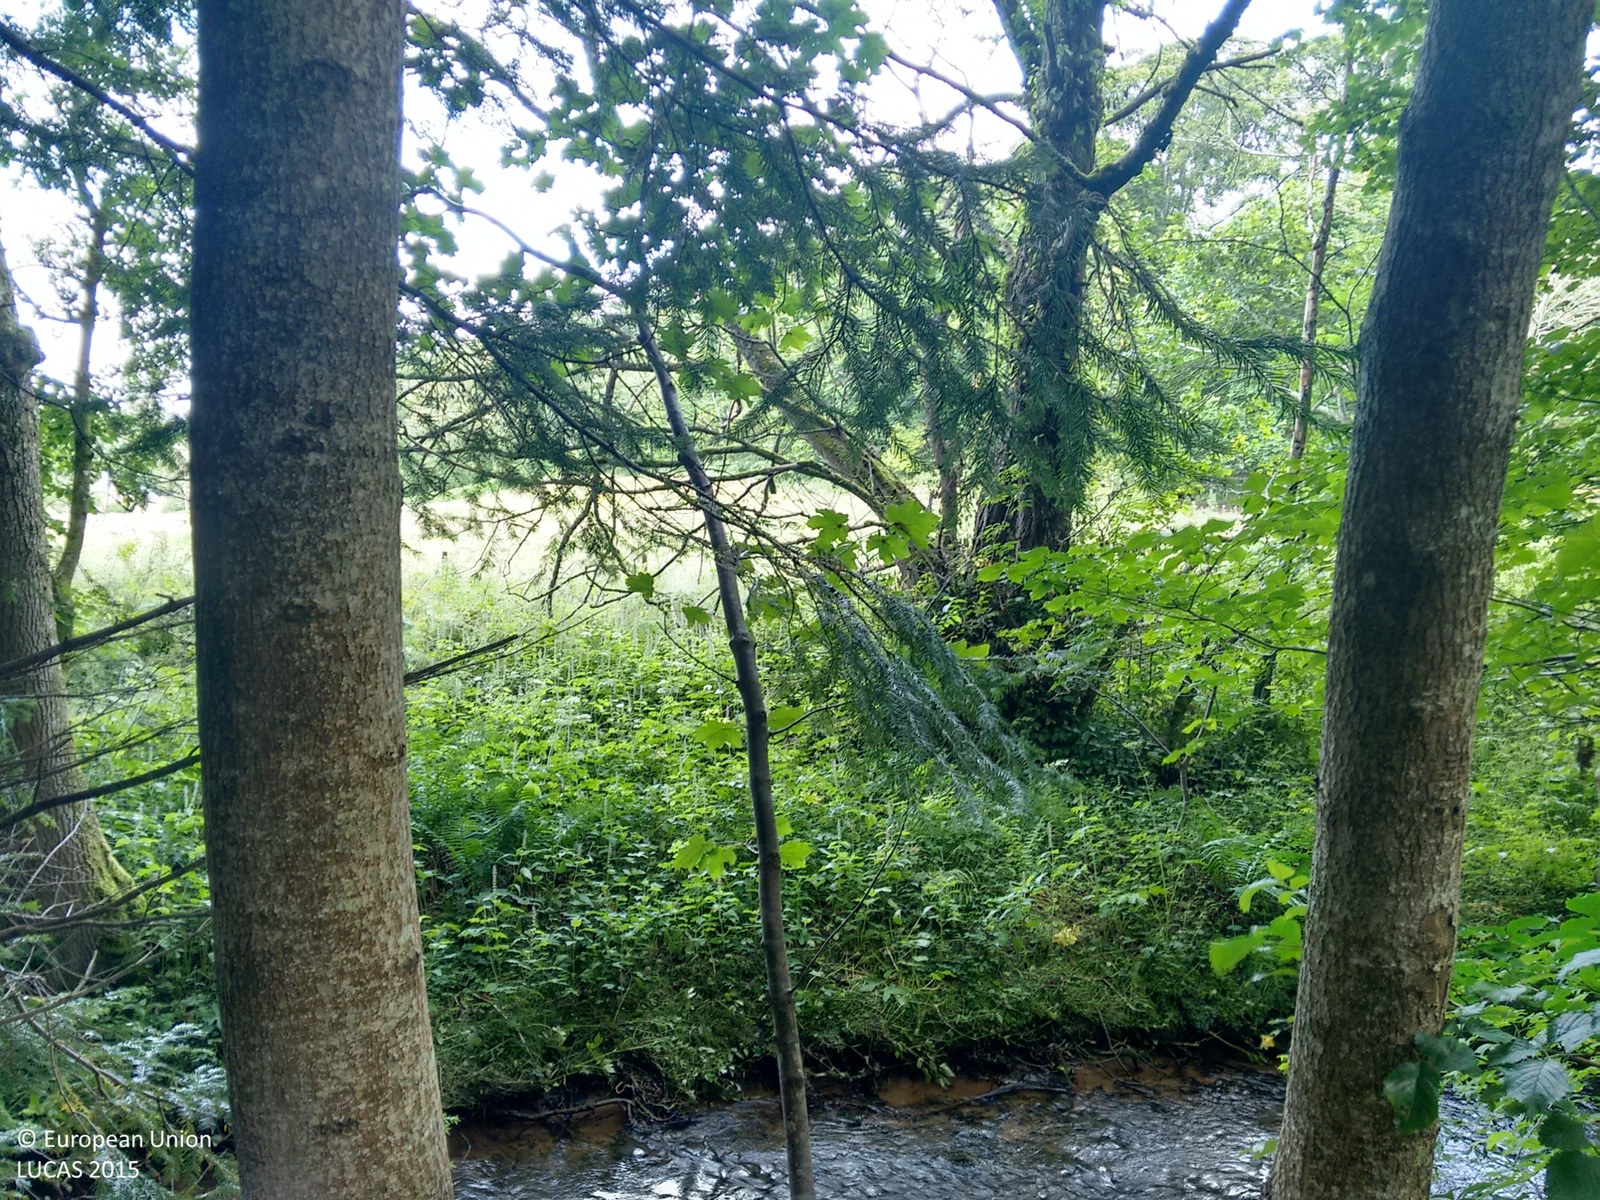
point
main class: Woodland
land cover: Broadleaved woodland
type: floodplain forest
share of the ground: > 75 %
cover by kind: broadleaved forest trees 95 %, coniferous forest trees 5 %
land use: Semi-natural and natural areas not in use
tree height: > 5 m
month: August
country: GB
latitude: 57.5686
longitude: -4.2116
